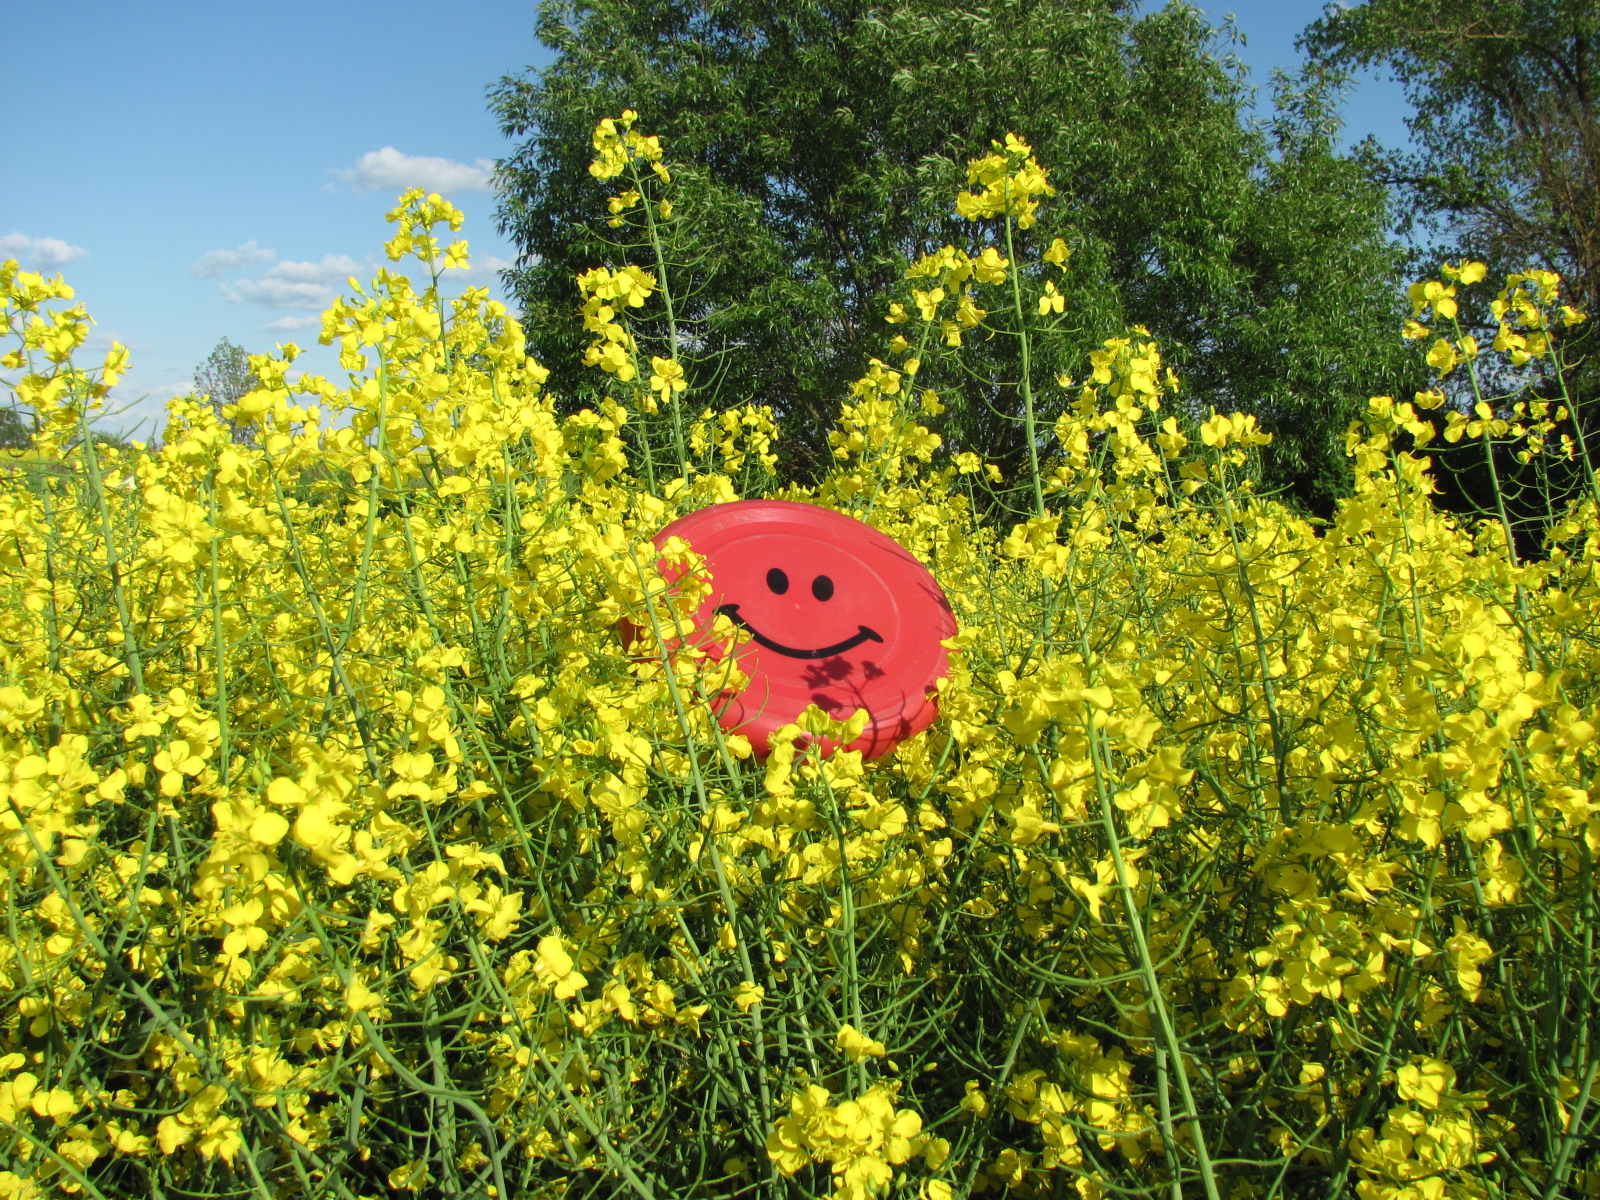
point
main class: Cropland
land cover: Rape and turnip rape
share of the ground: > 75 %
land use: Agriculture (excluding fallow land and kitchen gardens)
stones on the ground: < 10 %
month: May
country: LV
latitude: 56.5177
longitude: 23.9477
